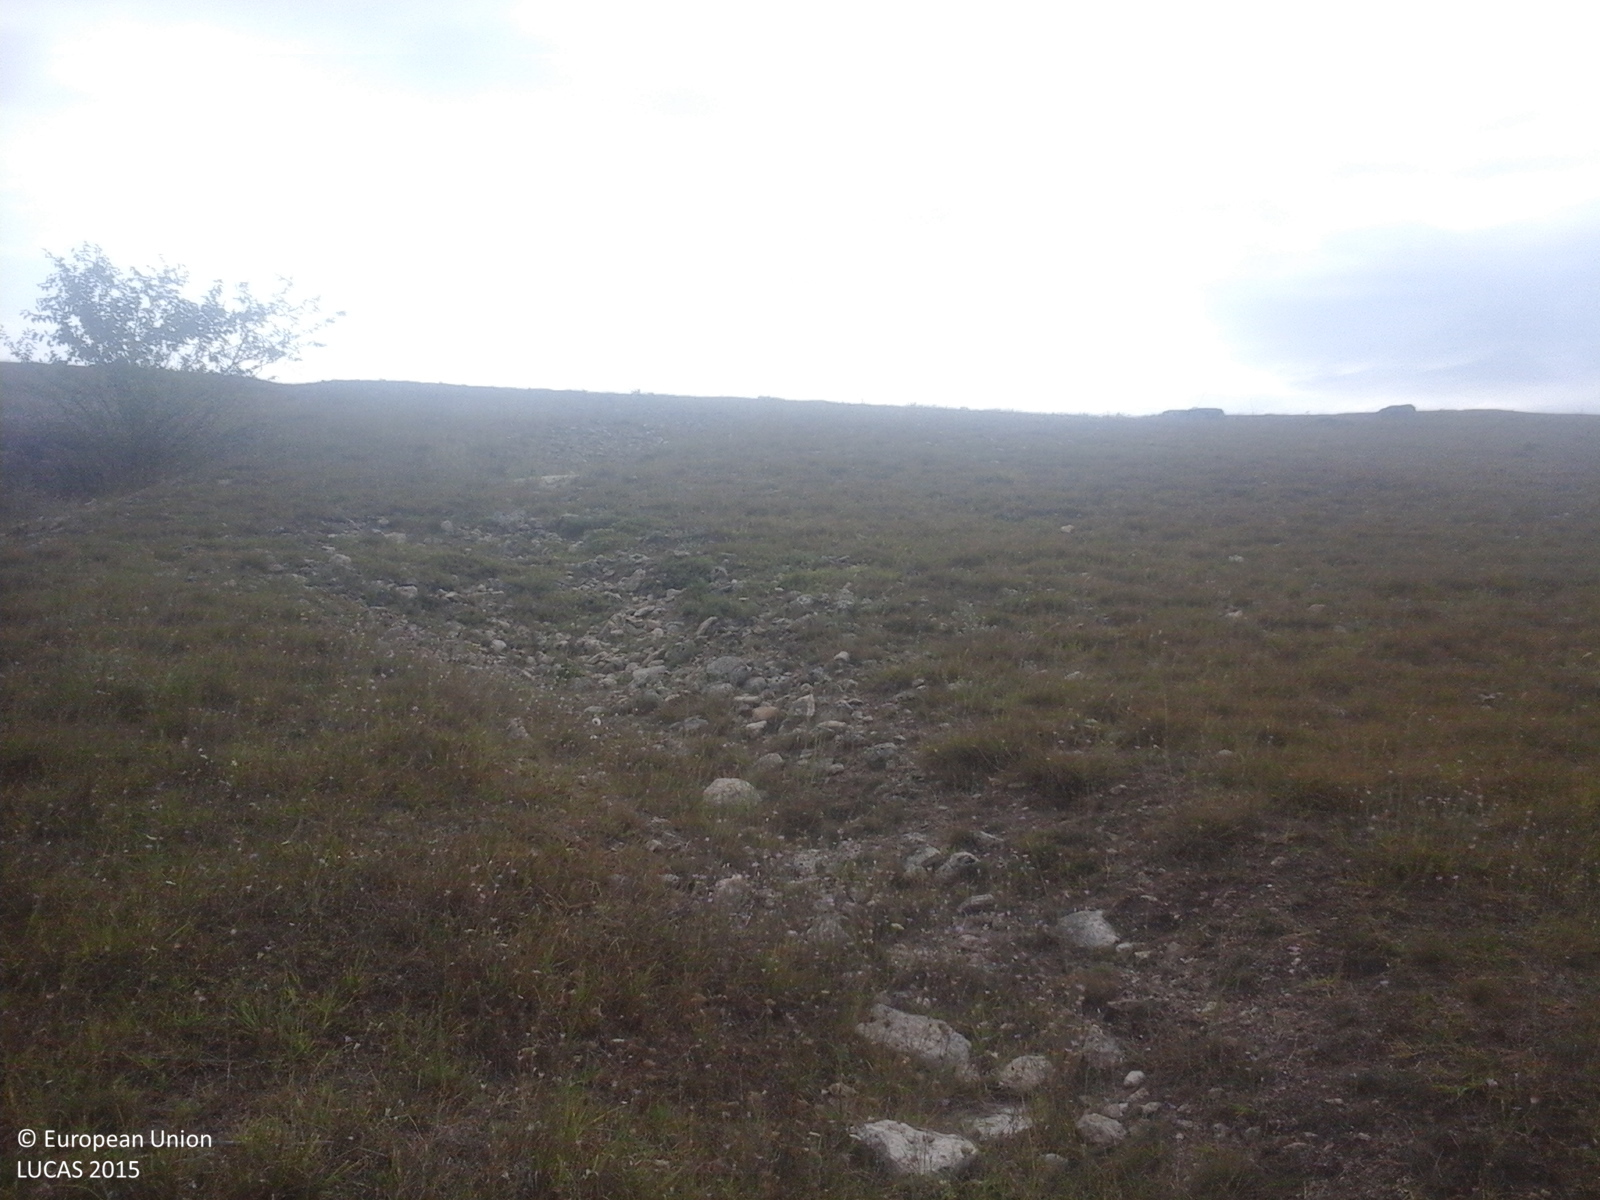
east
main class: Grassland
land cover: Grassland without tree/shrub cover
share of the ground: > 75 %
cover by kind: herbaceous plants 100 %
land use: Agriculture (excluding fallow land and kitchen gardens)
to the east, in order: Grassland without tree/shrub cover; Tracks; Grassland without tree/shrub cover; Common wheat
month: August
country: RO
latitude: 43.9623
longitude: 28.1912
